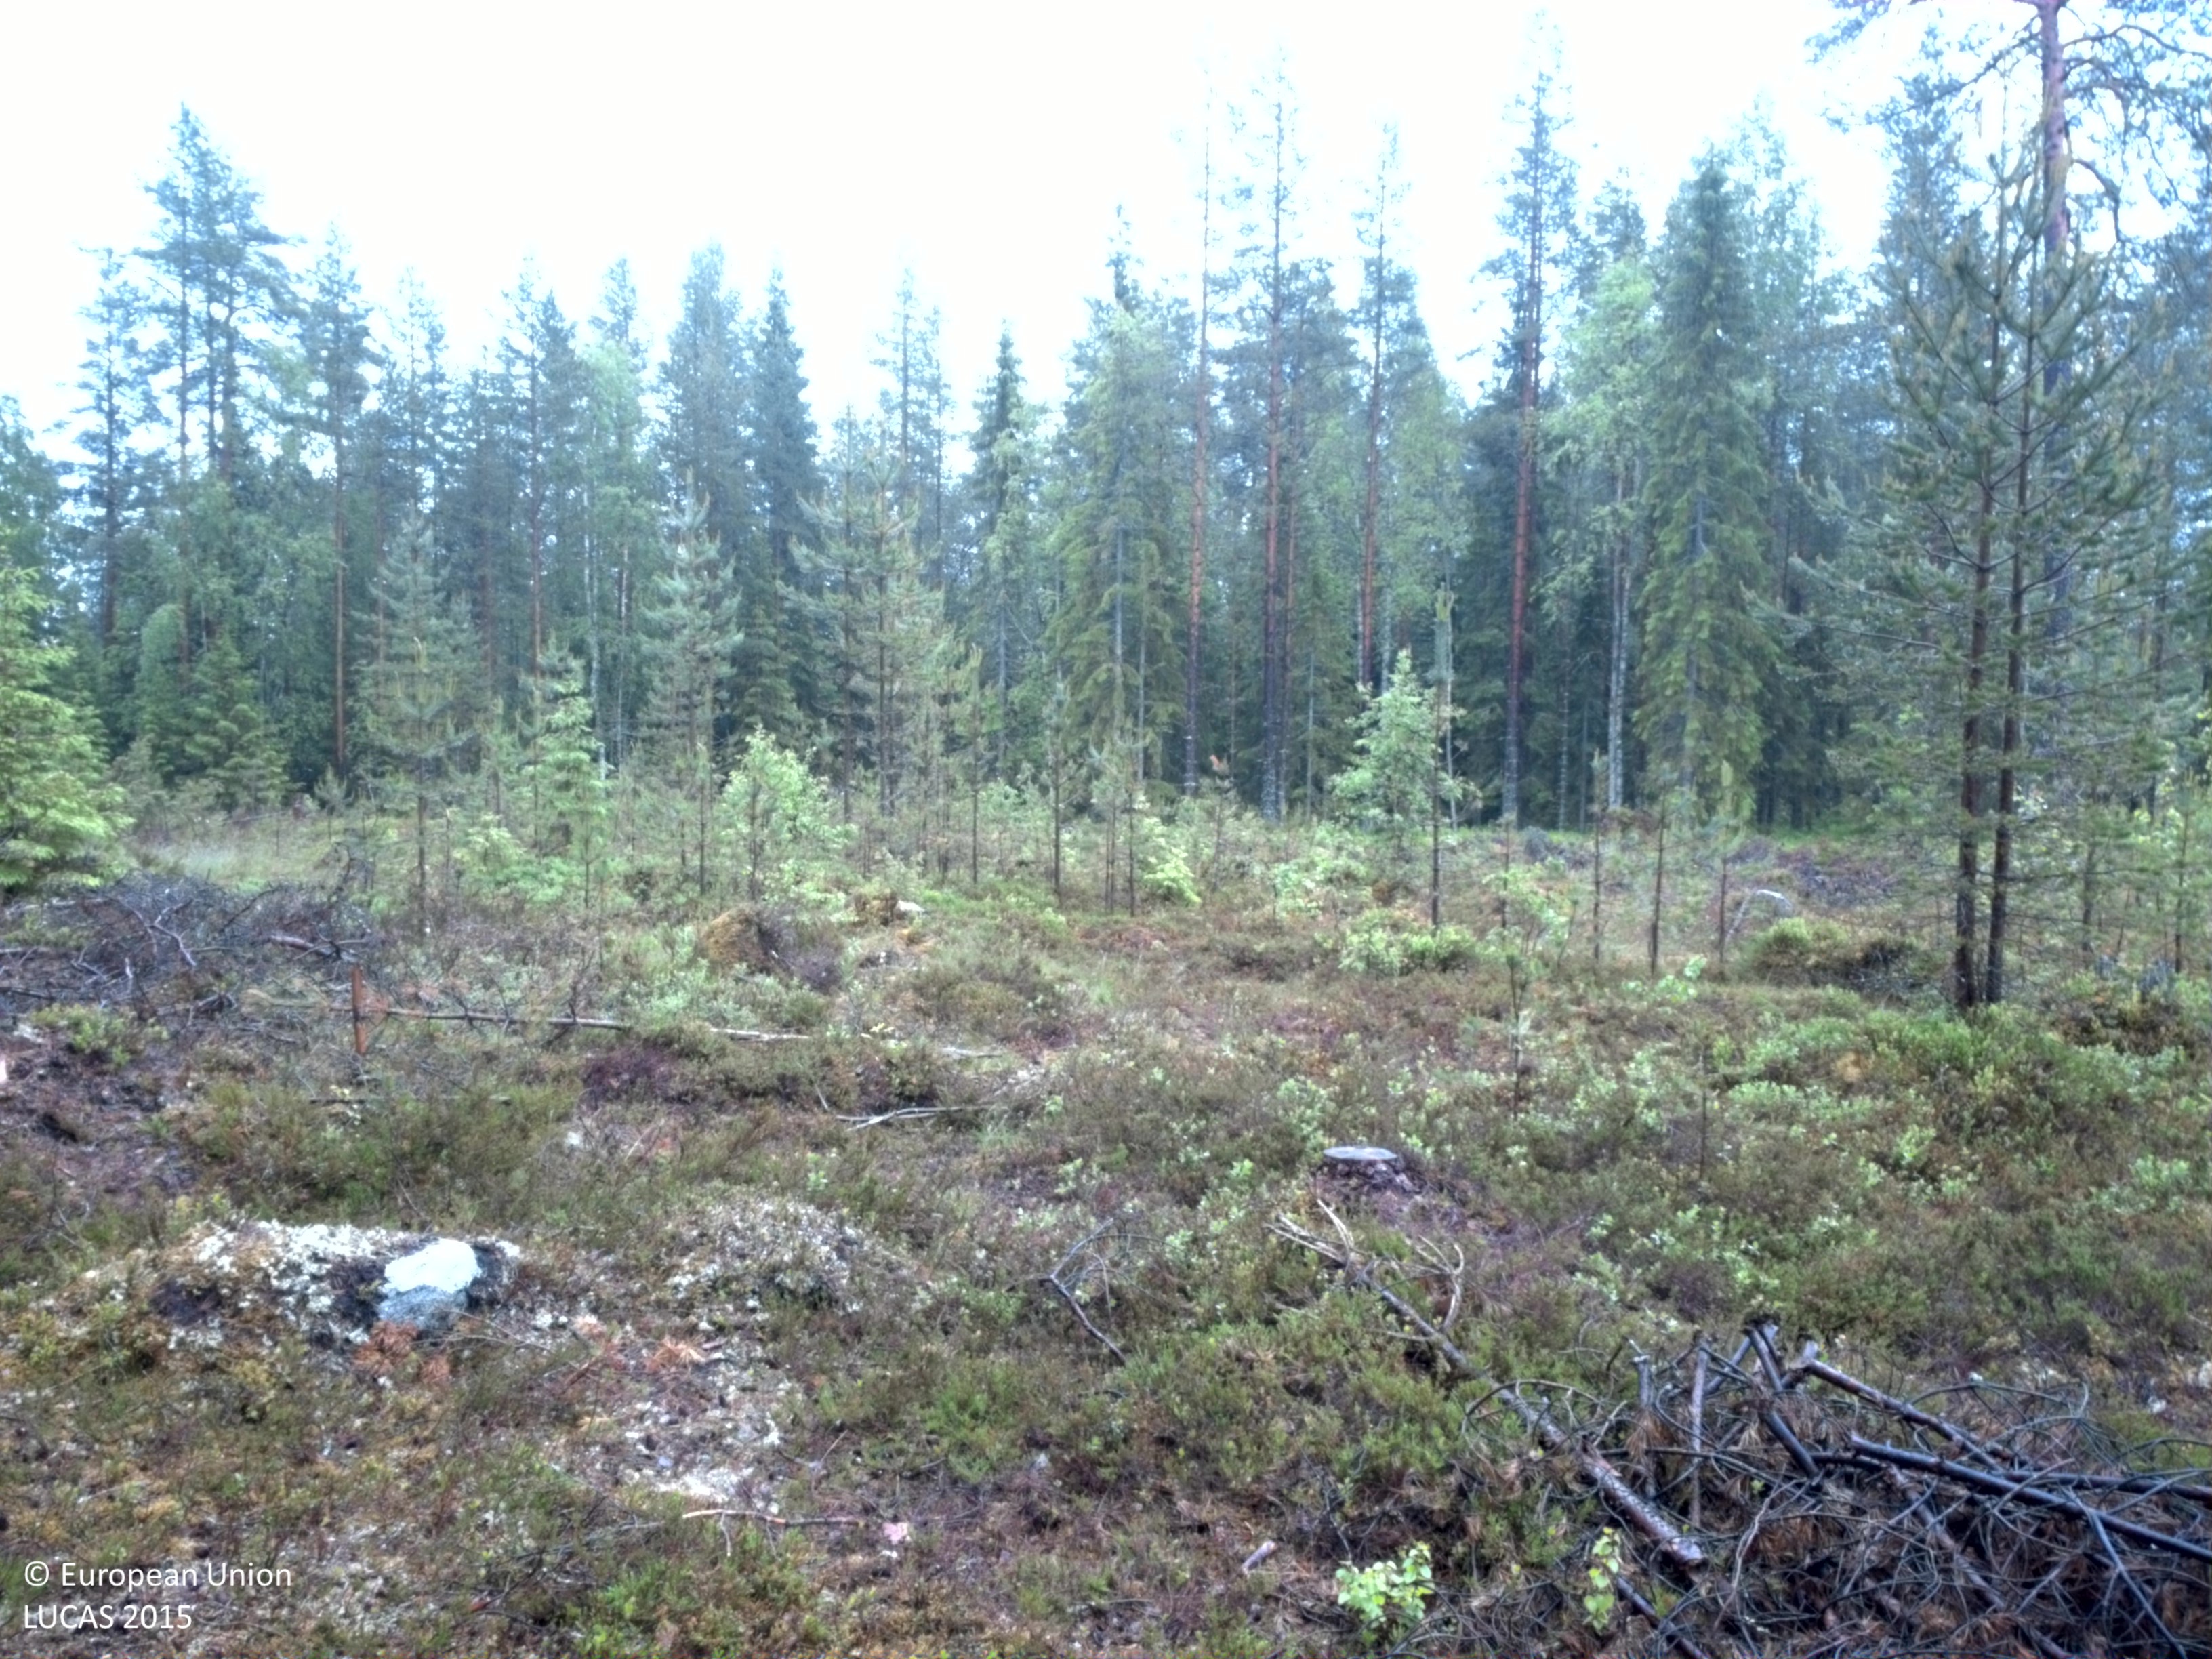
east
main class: Woodland
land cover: Other coniferous woodland
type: boreal forest
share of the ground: 50 - 75 %
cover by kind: coniferous forest trees 60 %, shrubs 20 %, broadleaved forest trees 15 %, lichens and mosses 5 %
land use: Forestry
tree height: > 5 m
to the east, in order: Shrubland with sparse tree cover; Spruce dominated coniferous woodland; Ditches and canals; Spruce dominated mixed woodland; Pine dominated coniferous woodland; Ditches and canals; Pine dominated coniferous woodland; Peatbogs; Pine dominated coniferous woodland
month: June
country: SE
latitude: 64.3511
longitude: 20.8935
